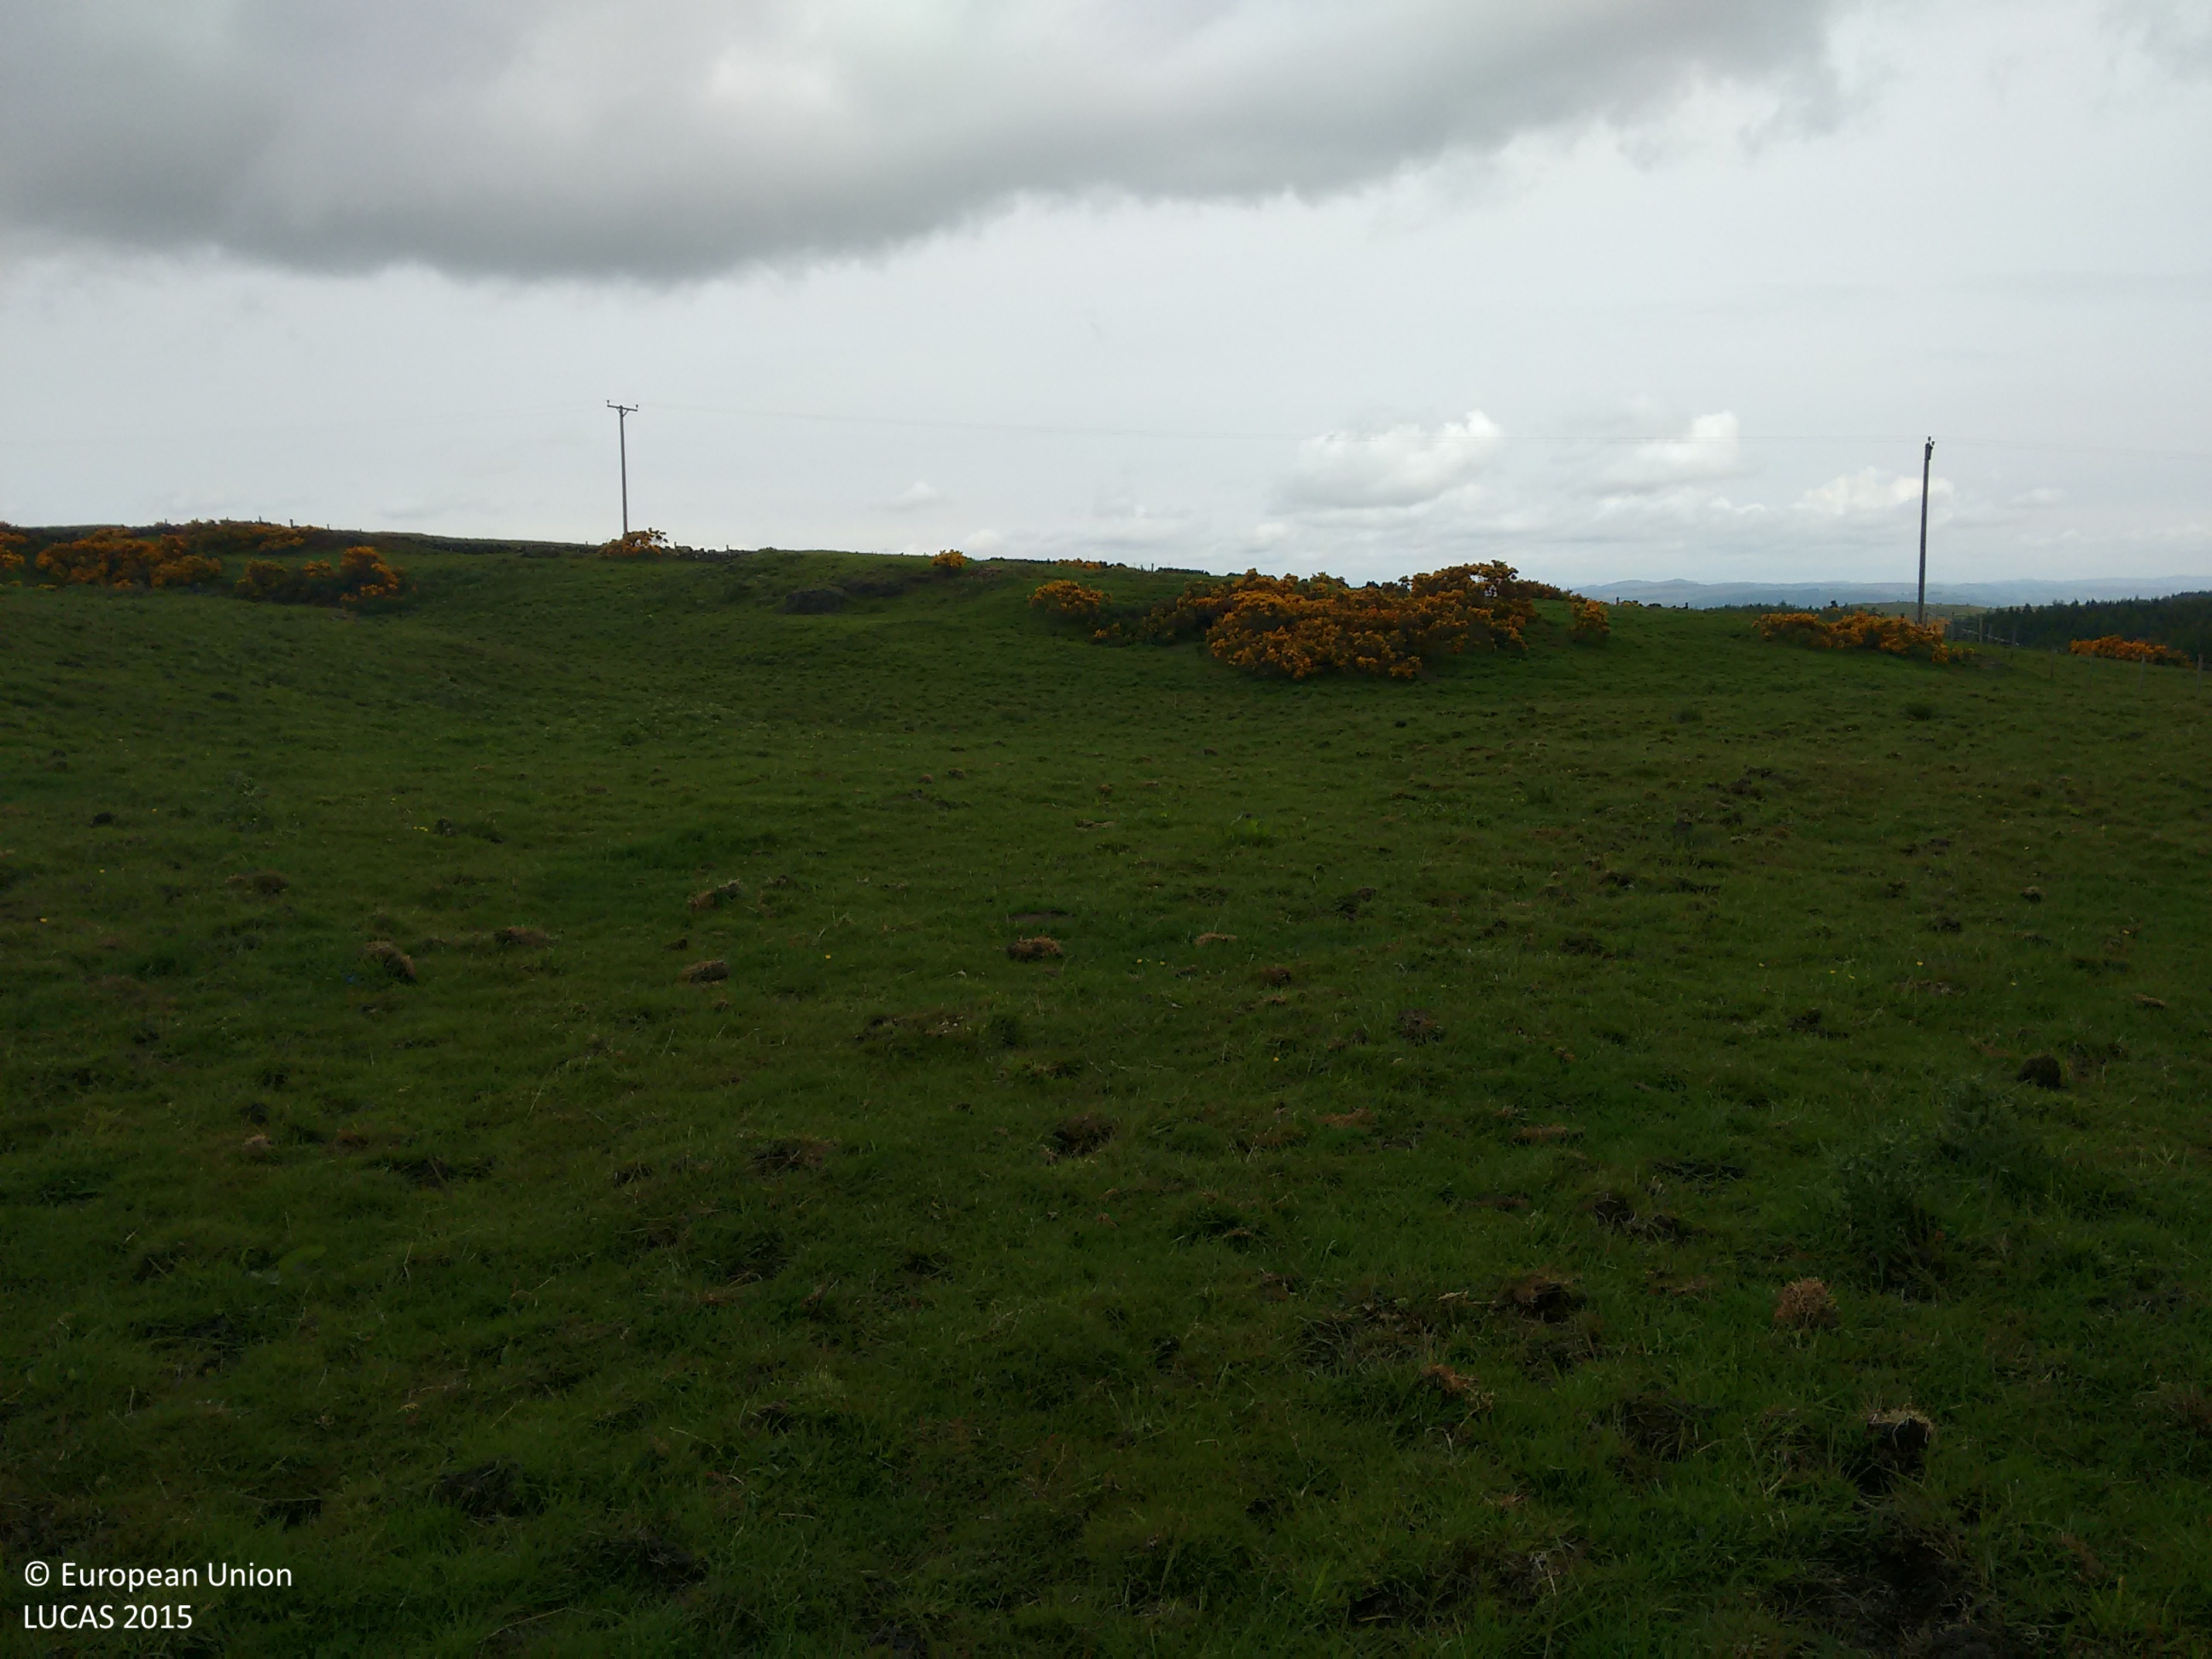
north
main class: Grassland
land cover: Grassland without tree/shrub cover
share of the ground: > 75 %
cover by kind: herbaceous plants 100 %
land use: Agriculture (excluding fallow land and kitchen gardens)
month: June
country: GB
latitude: 56.3015
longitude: -3.4069
